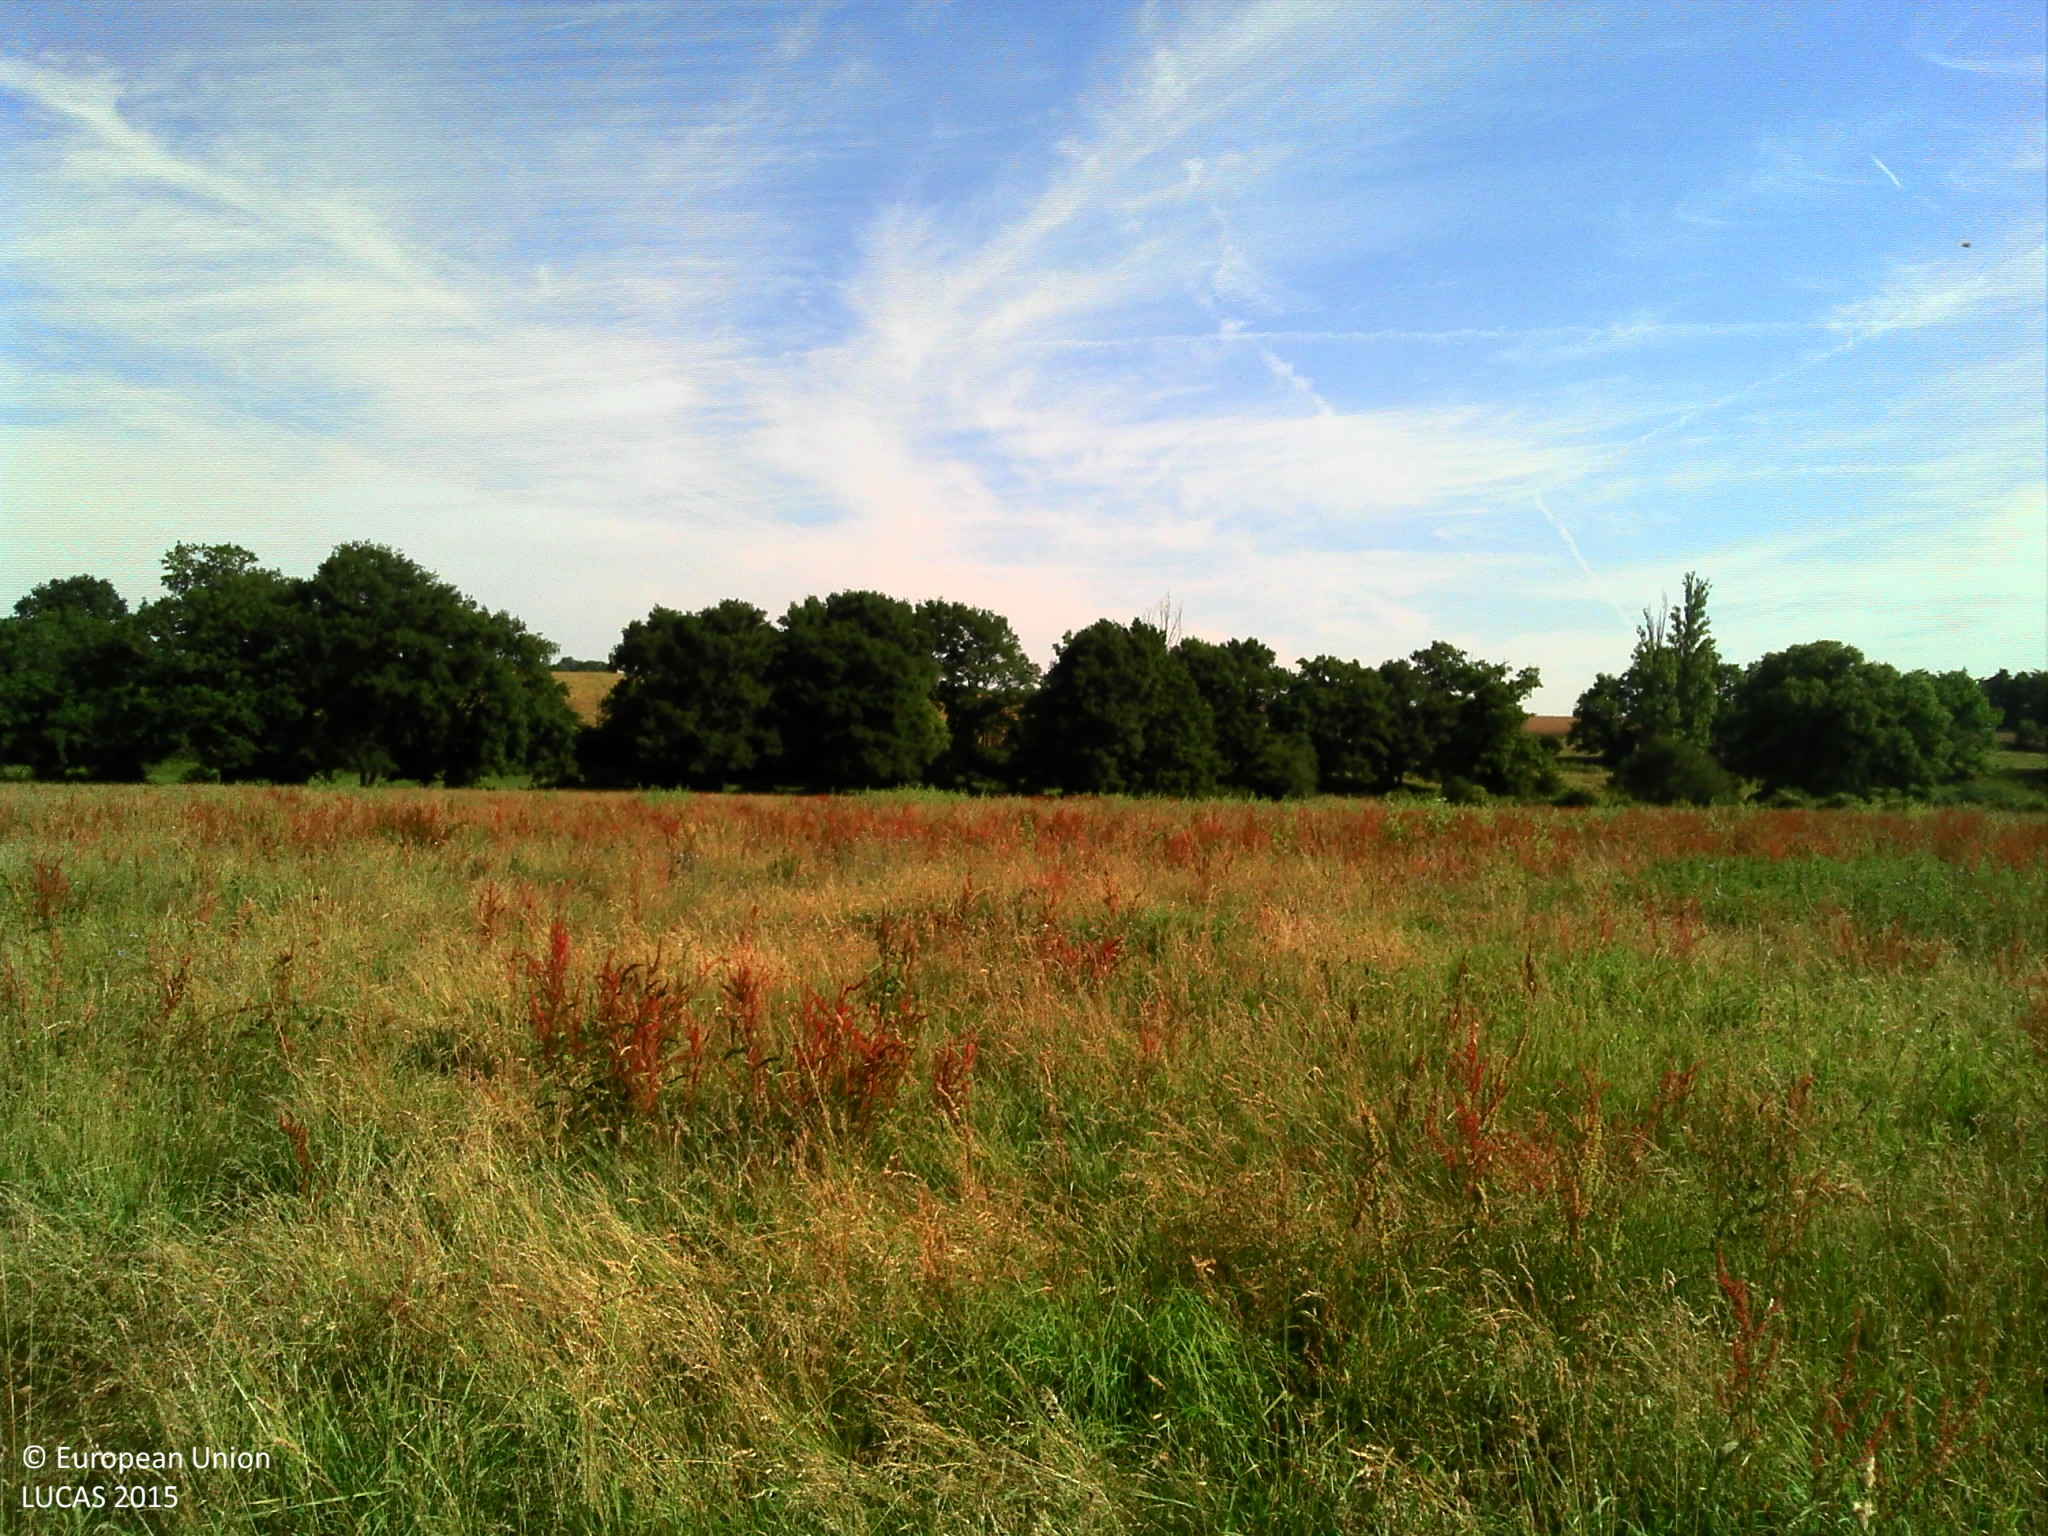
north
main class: Grassland
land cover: Grassland without tree/shrub cover
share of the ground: > 75 %
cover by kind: herbaceous plants 100 %
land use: Agriculture (excluding fallow land and kitchen gardens)
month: June
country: FR
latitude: 45.7404
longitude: 0.4360
